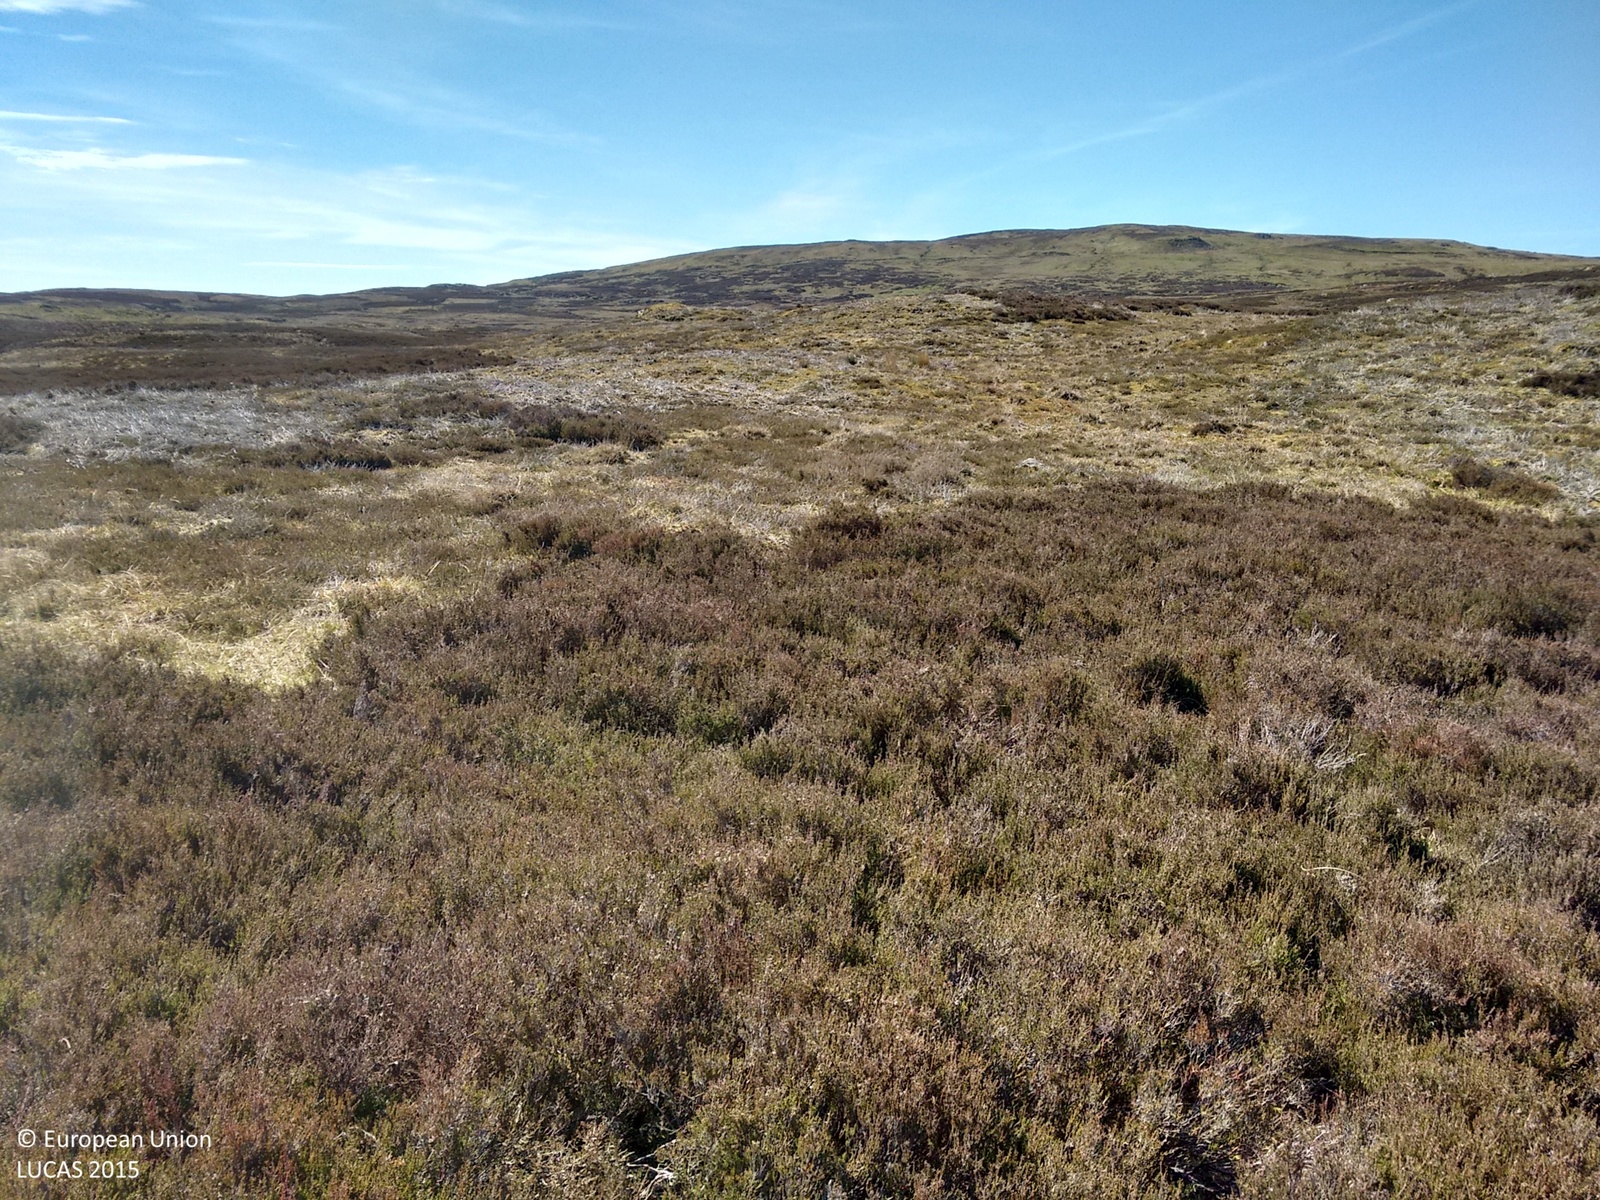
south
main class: Shrubland
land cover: Shrubland without tree cover
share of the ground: > 75 %
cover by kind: shrubs 70 %, herbaceous plants 25 %, lichens and mosses 5 %
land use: Agriculture (excluding fallow land and kitchen gardens)
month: June
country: GB
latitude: 56.5705
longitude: -3.9672
